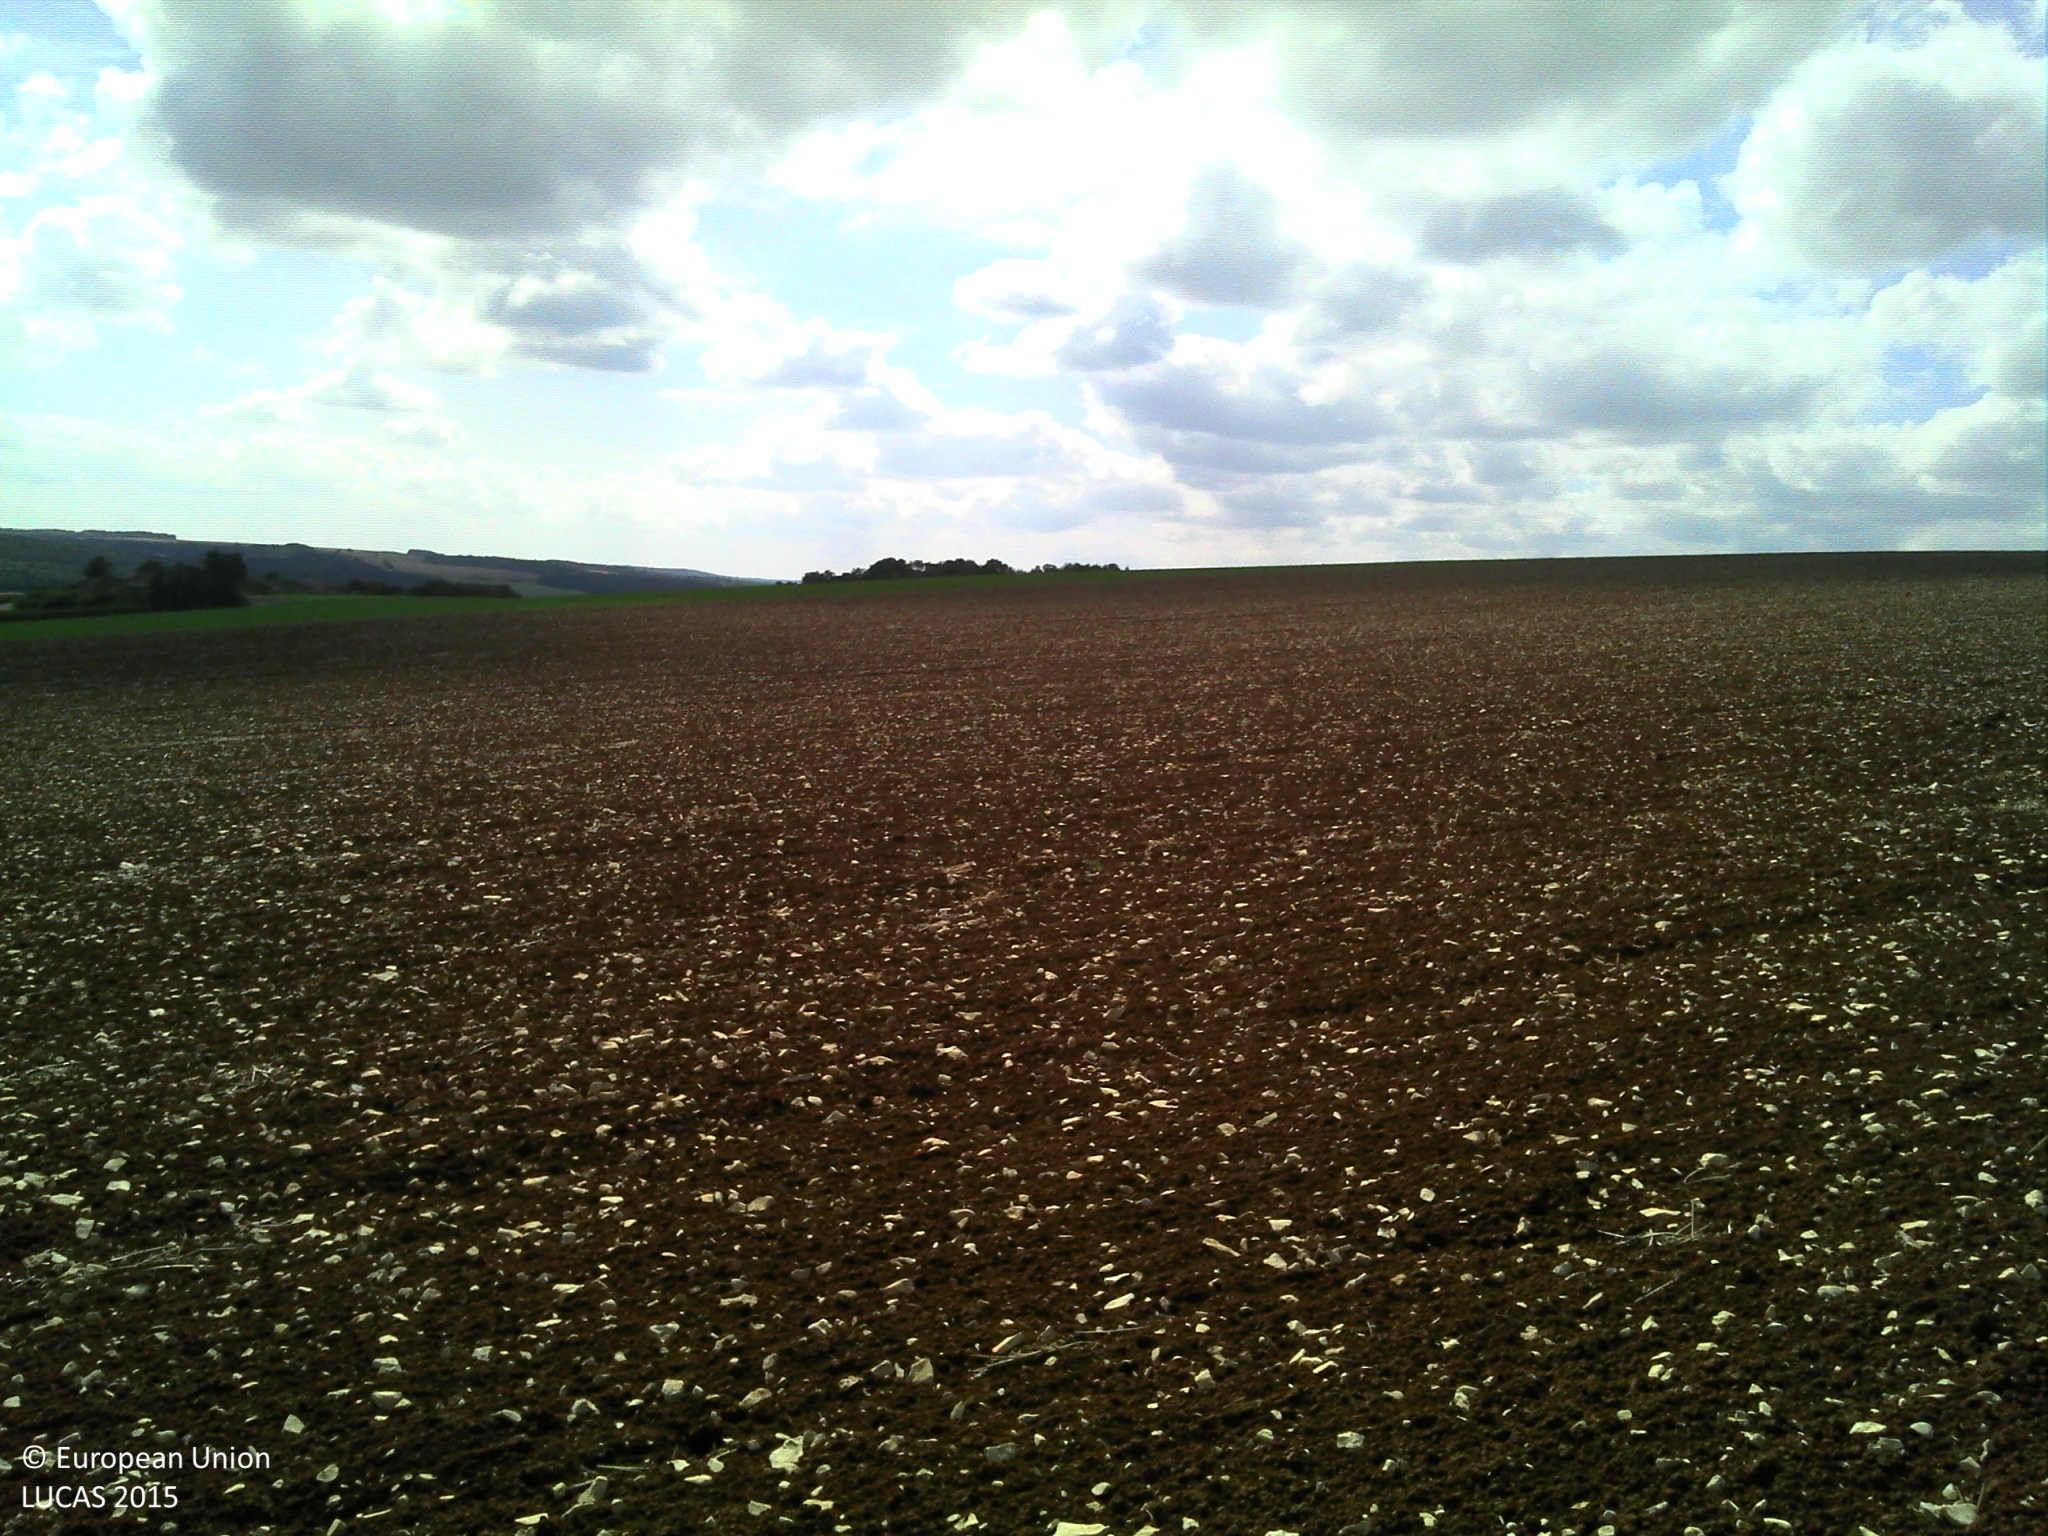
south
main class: Cropland
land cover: Barley
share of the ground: < 10 %
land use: Agriculture (excluding fallow land and kitchen gardens)
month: September
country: FR
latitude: 48.0040
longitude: 4.3010
